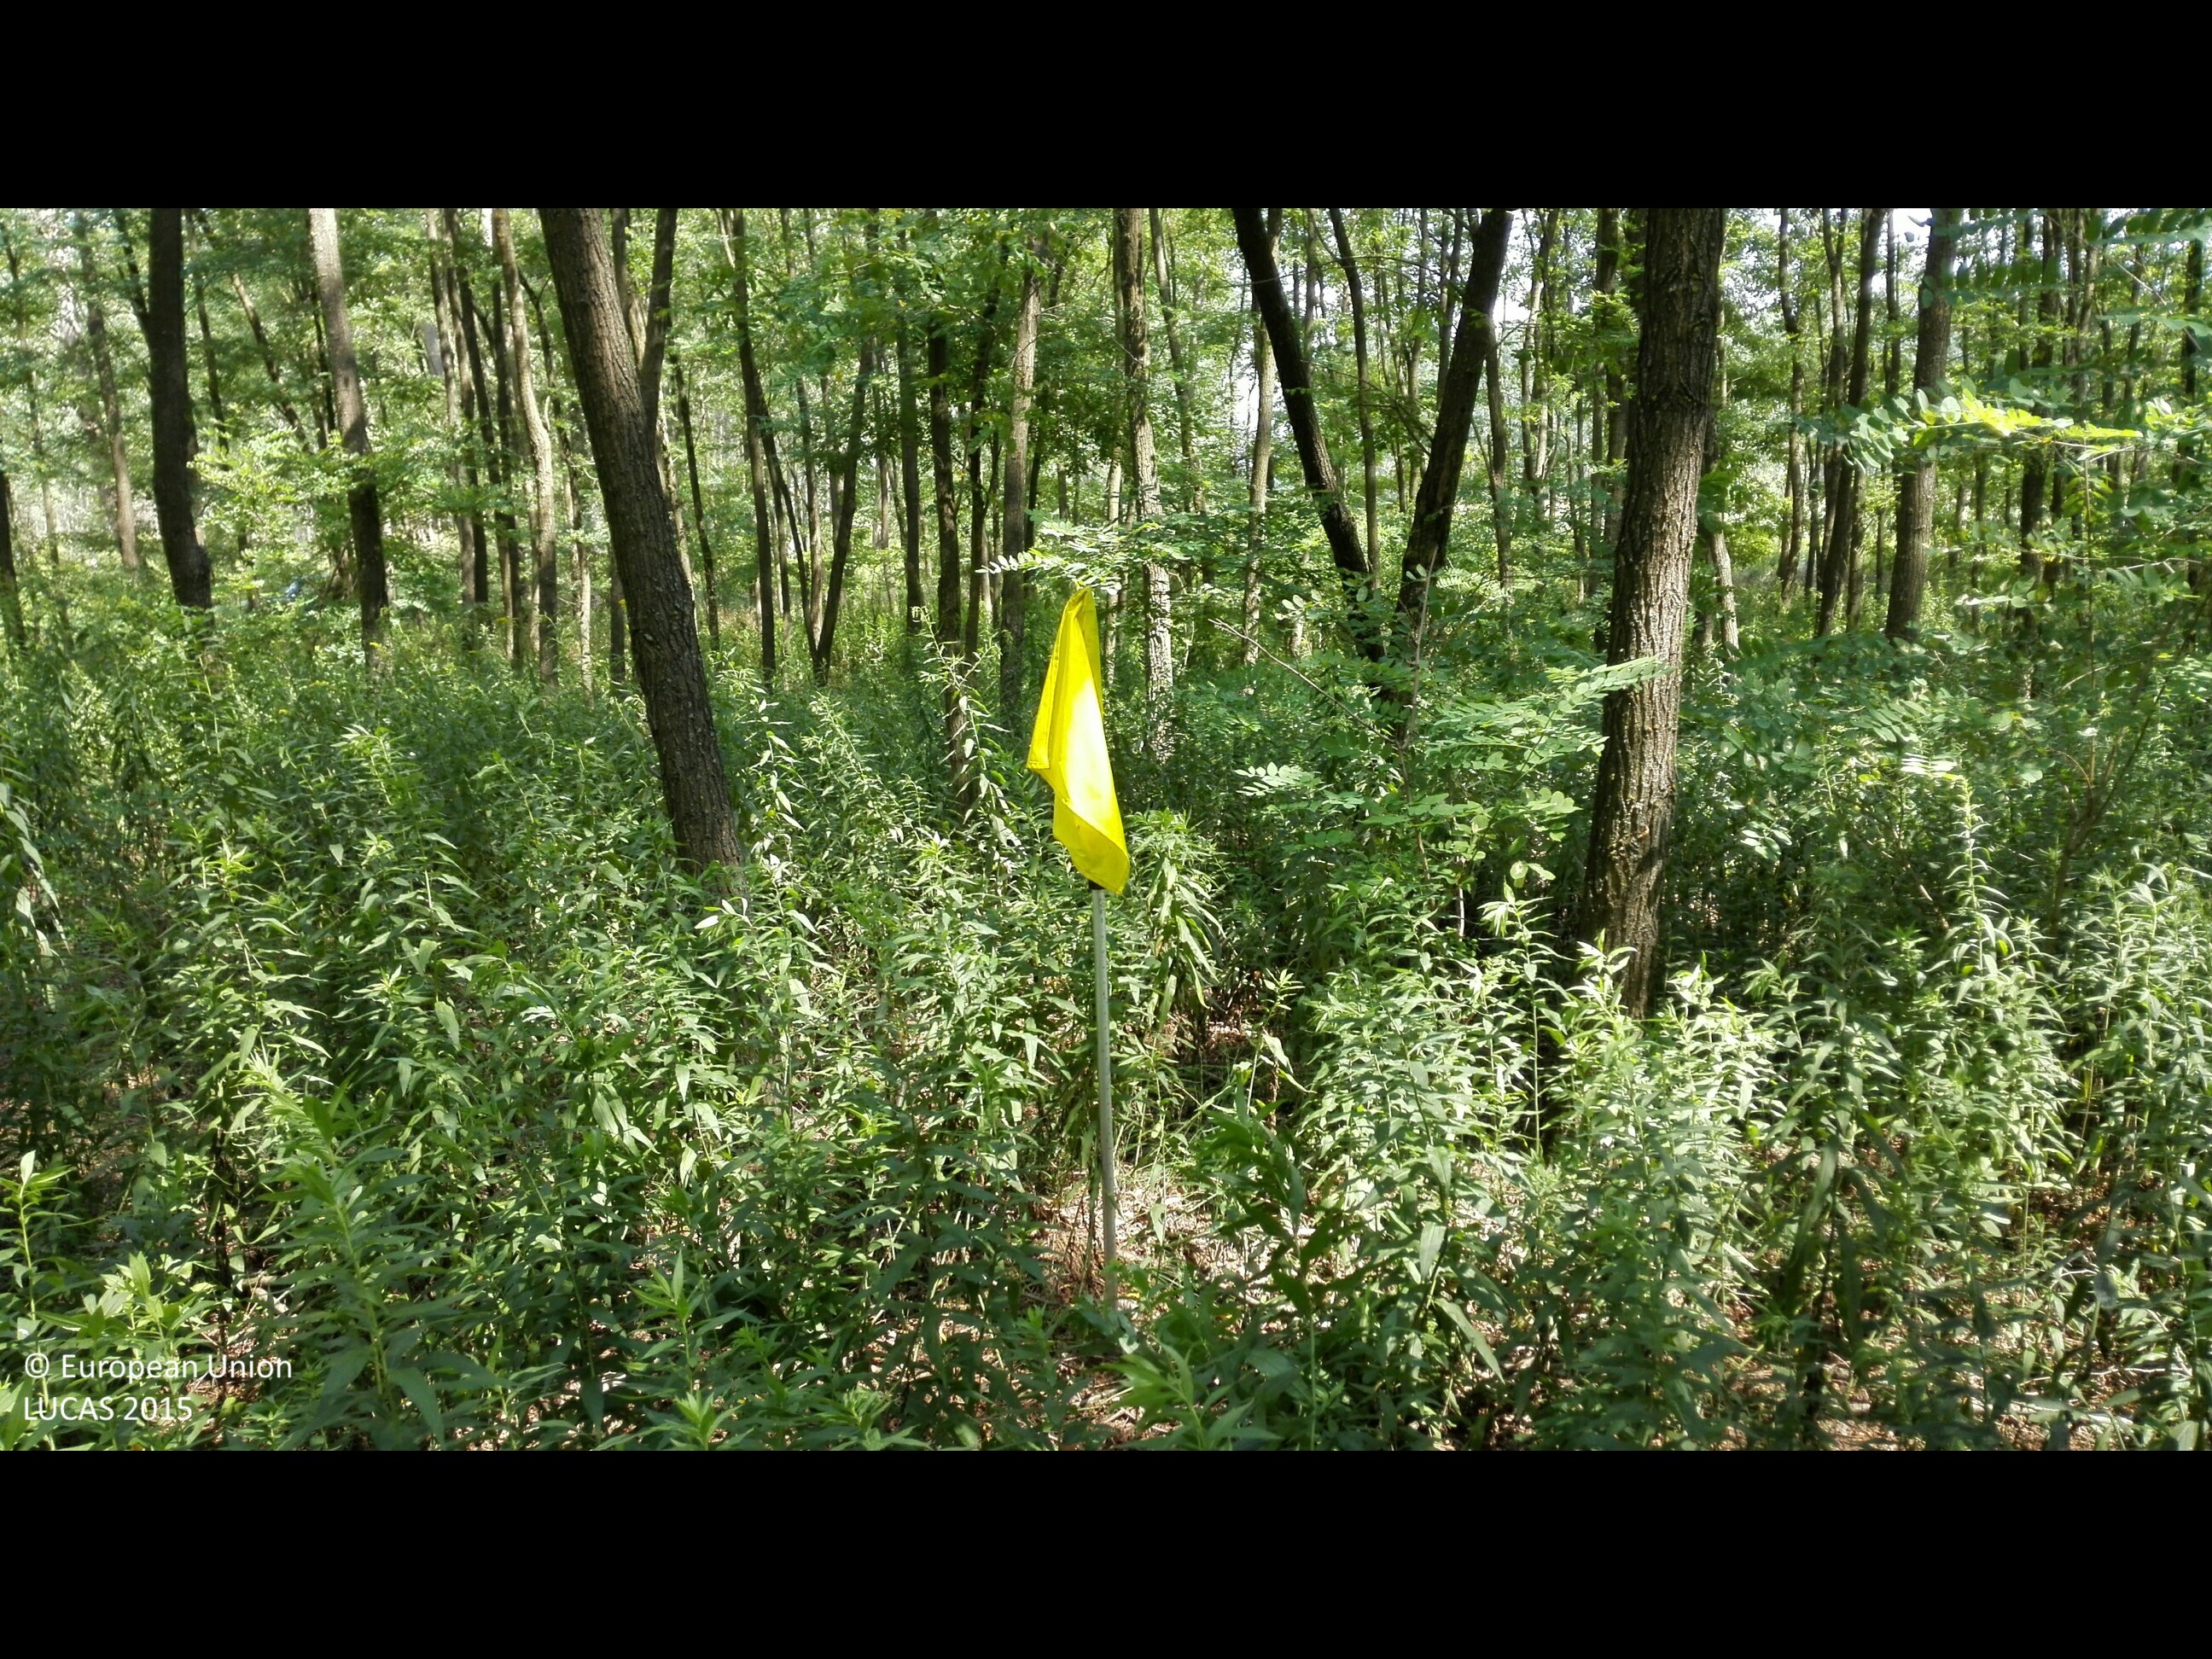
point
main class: Woodland
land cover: Broadleaved woodland
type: exotic forest
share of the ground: > 75 %
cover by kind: broadleaved forest trees 95 %, herbaceous plants 5 %
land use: Forestry
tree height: > 5 m
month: August
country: HU
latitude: 47.6686
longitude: 21.8884
